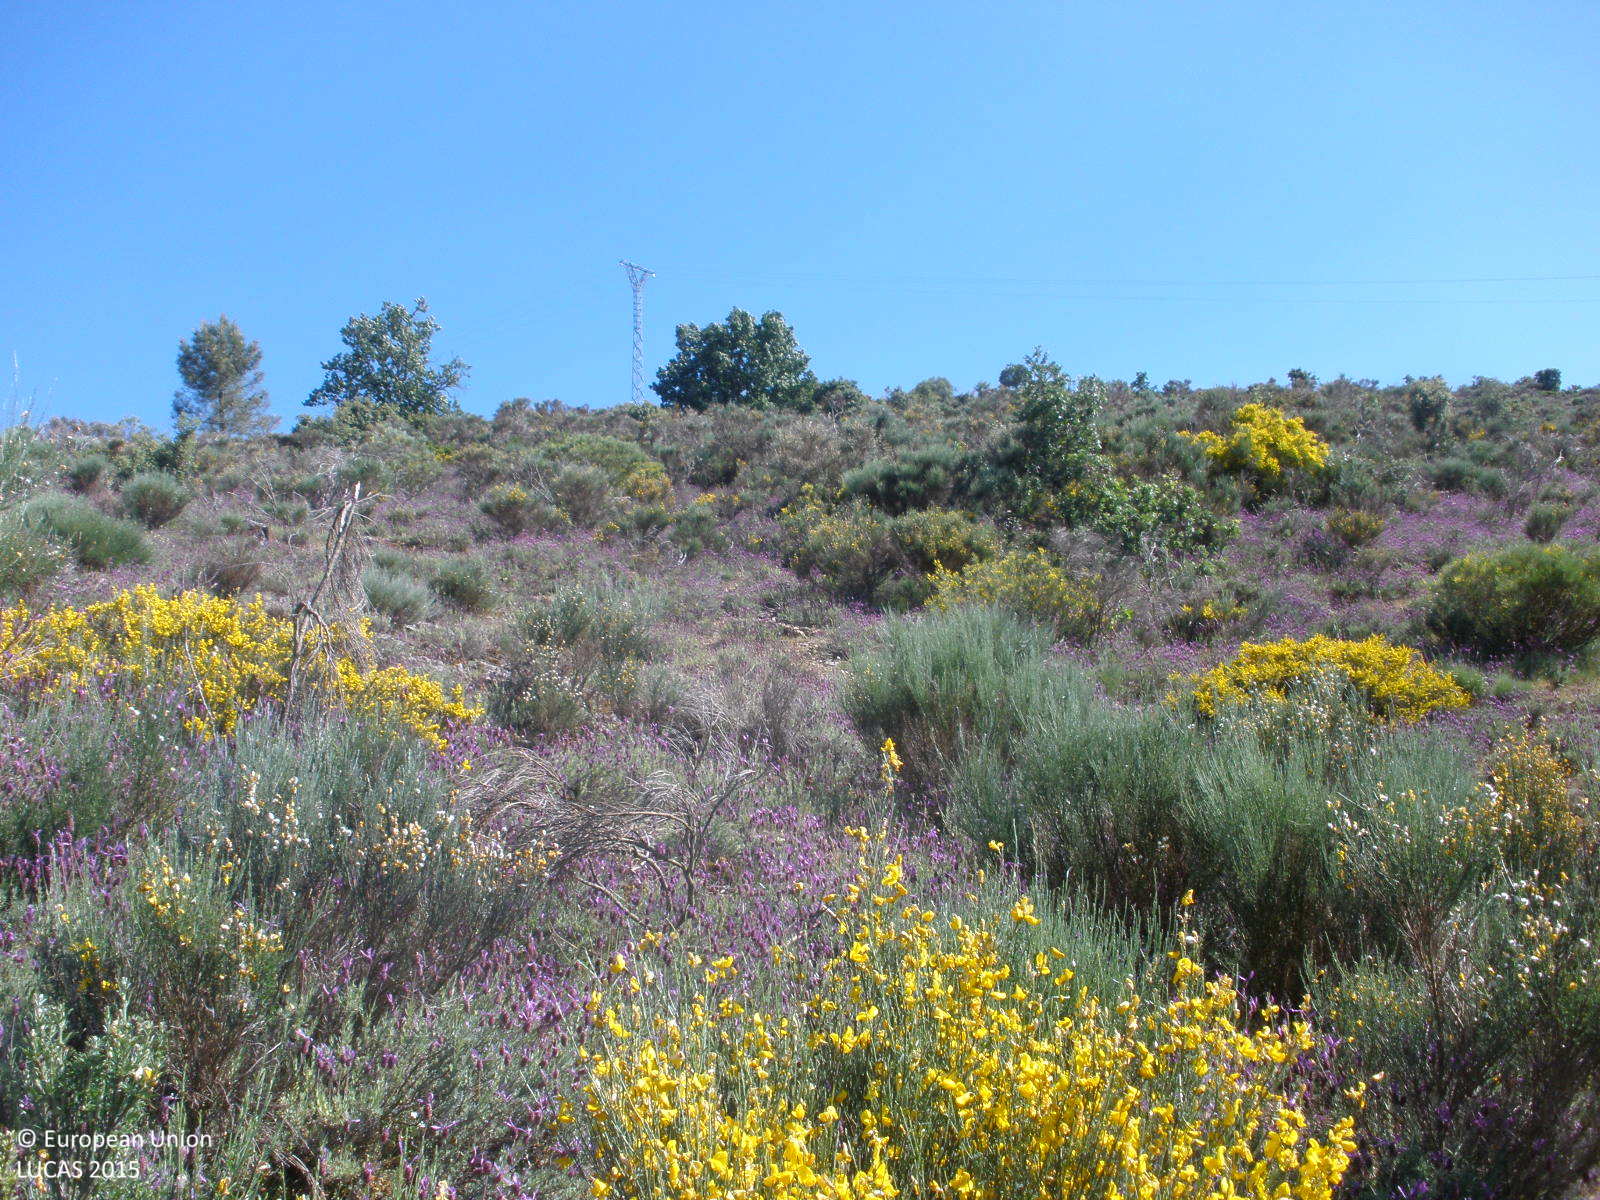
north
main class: Shrubland
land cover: Shrubland without tree cover
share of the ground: > 75 %
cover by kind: shrubs 80 %, herbaceous plants 20 %
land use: Agriculture (excluding fallow land and kitchen gardens)
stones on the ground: 25 - 50 %
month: May
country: ES
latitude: 40.5719
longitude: -6.0615
